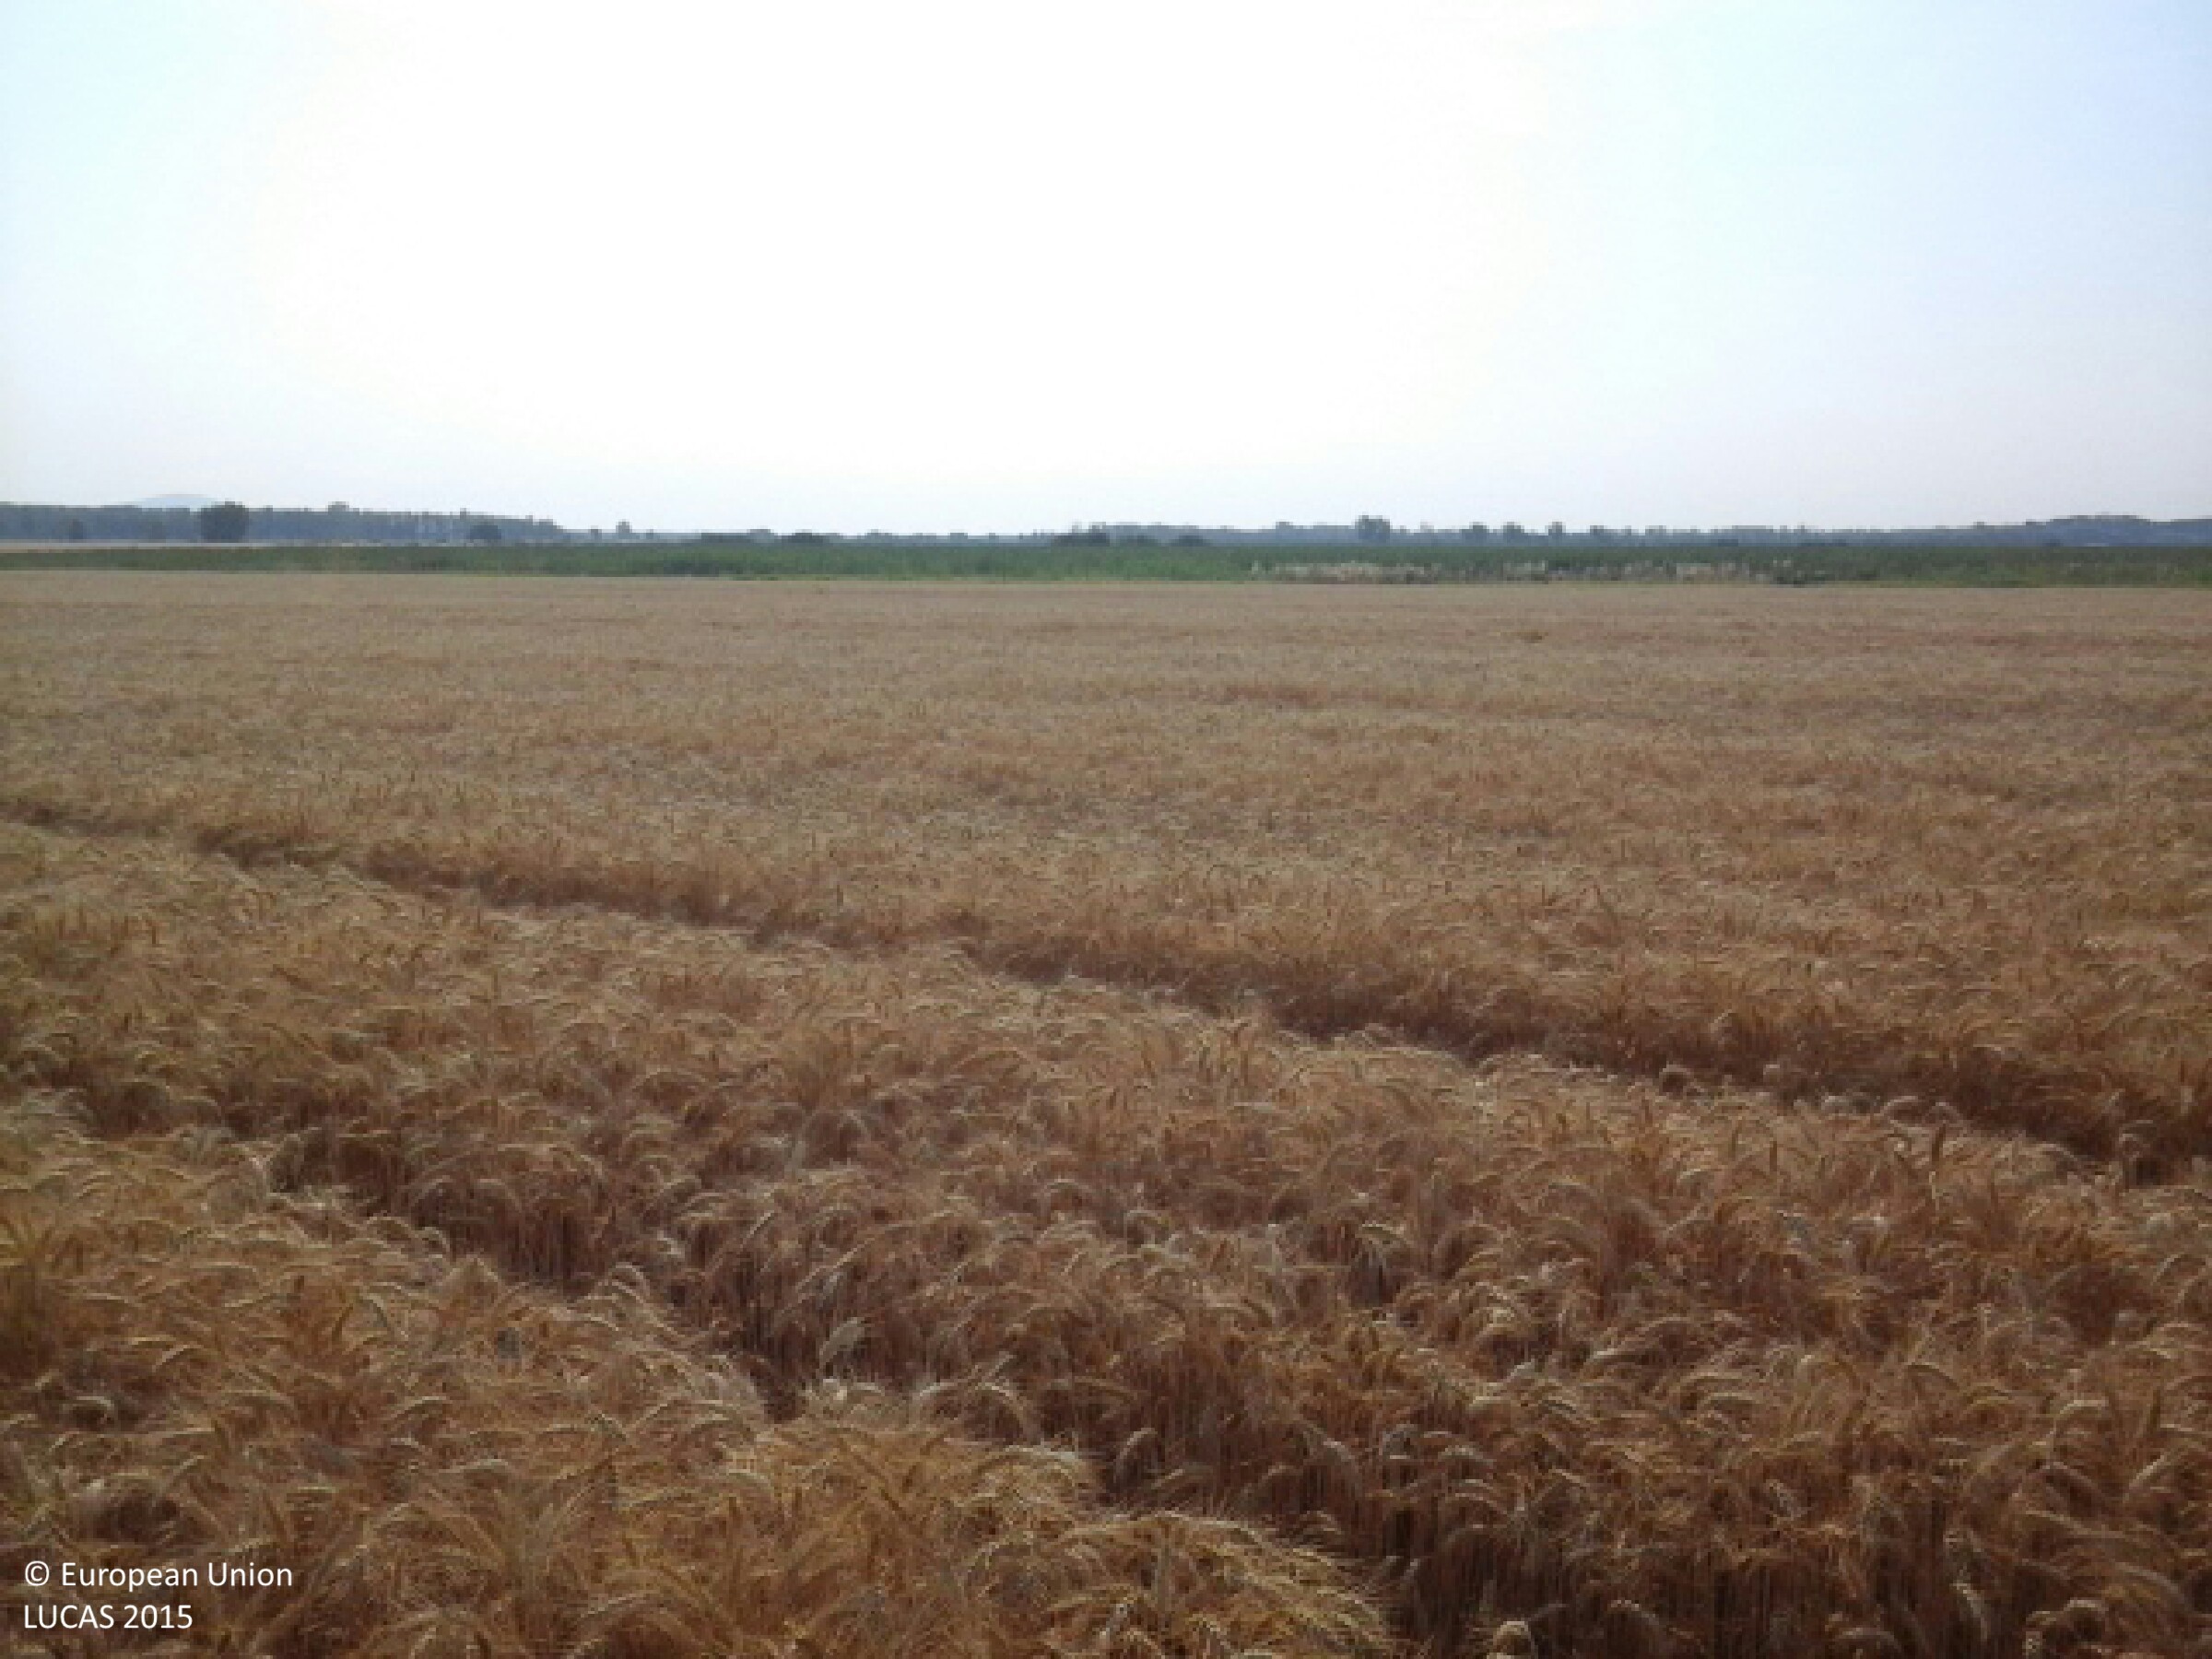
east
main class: Cropland
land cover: Barley
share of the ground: > 75 %
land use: Agriculture (excluding fallow land and kitchen gardens)
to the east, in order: Barley; Grassland without tree/shrub cover; Inland fresh running water; Grassland without tree/shrub cover; Sunflower
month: July
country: HU
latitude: 48.0596
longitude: 21.1103
